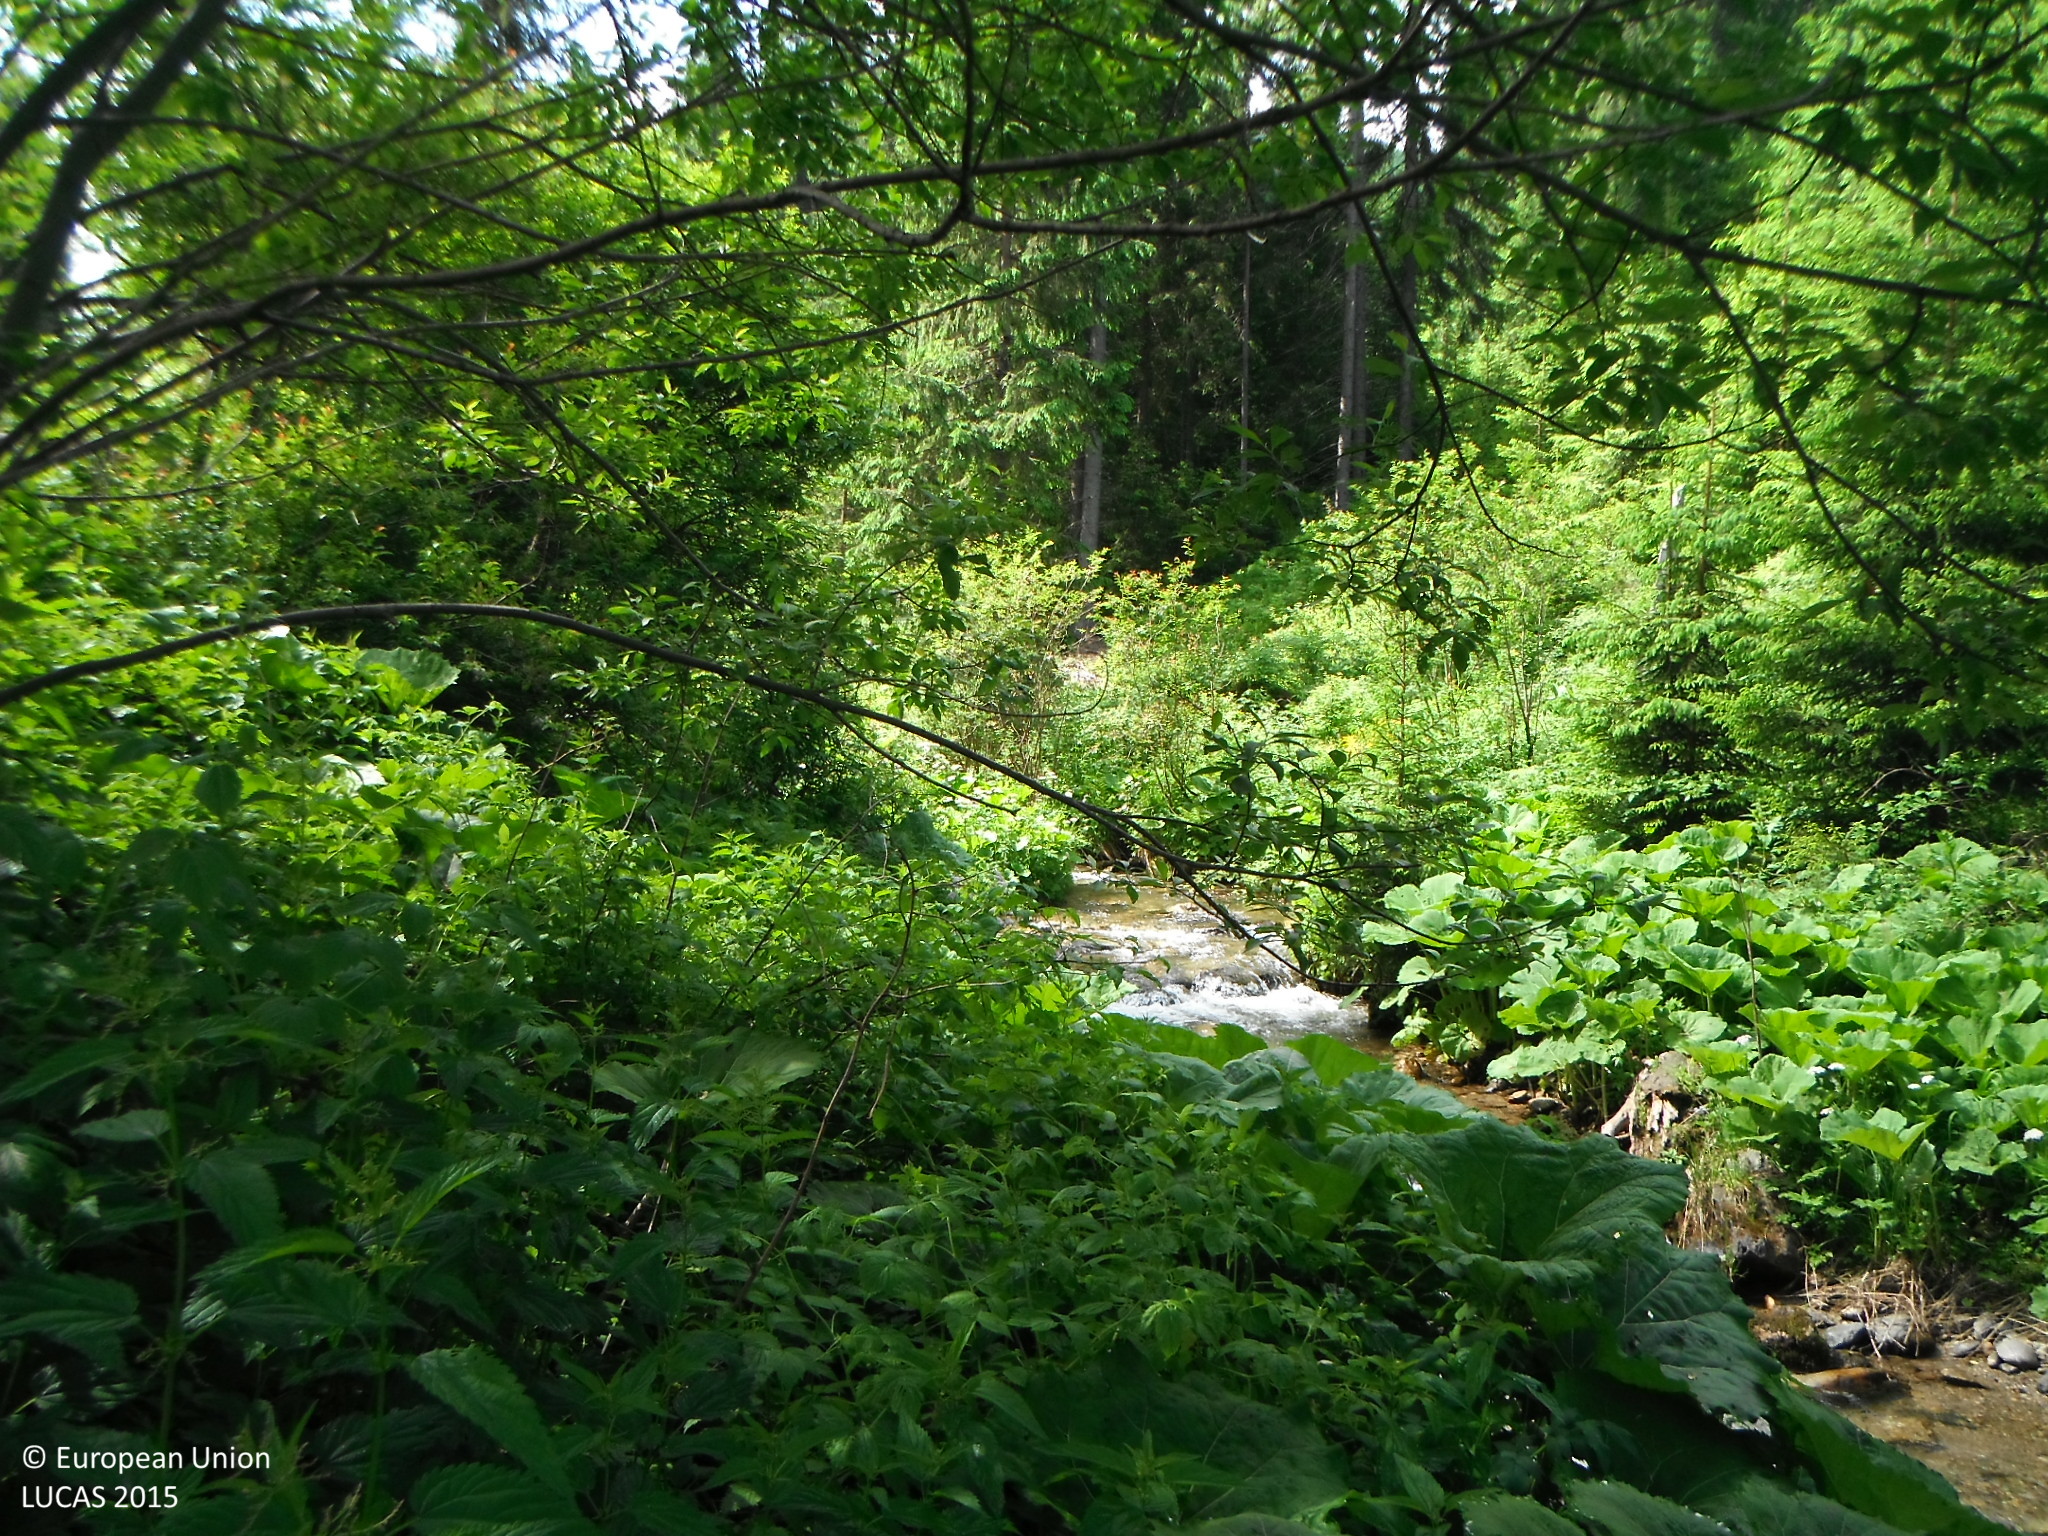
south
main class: Grassland
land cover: Spontaneously vegetated surfaces
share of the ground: > 75 %
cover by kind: herbaceous plants 100 %
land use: Semi-natural and natural areas not in use
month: June
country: SK
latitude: 48.9450
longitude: 20.0116
